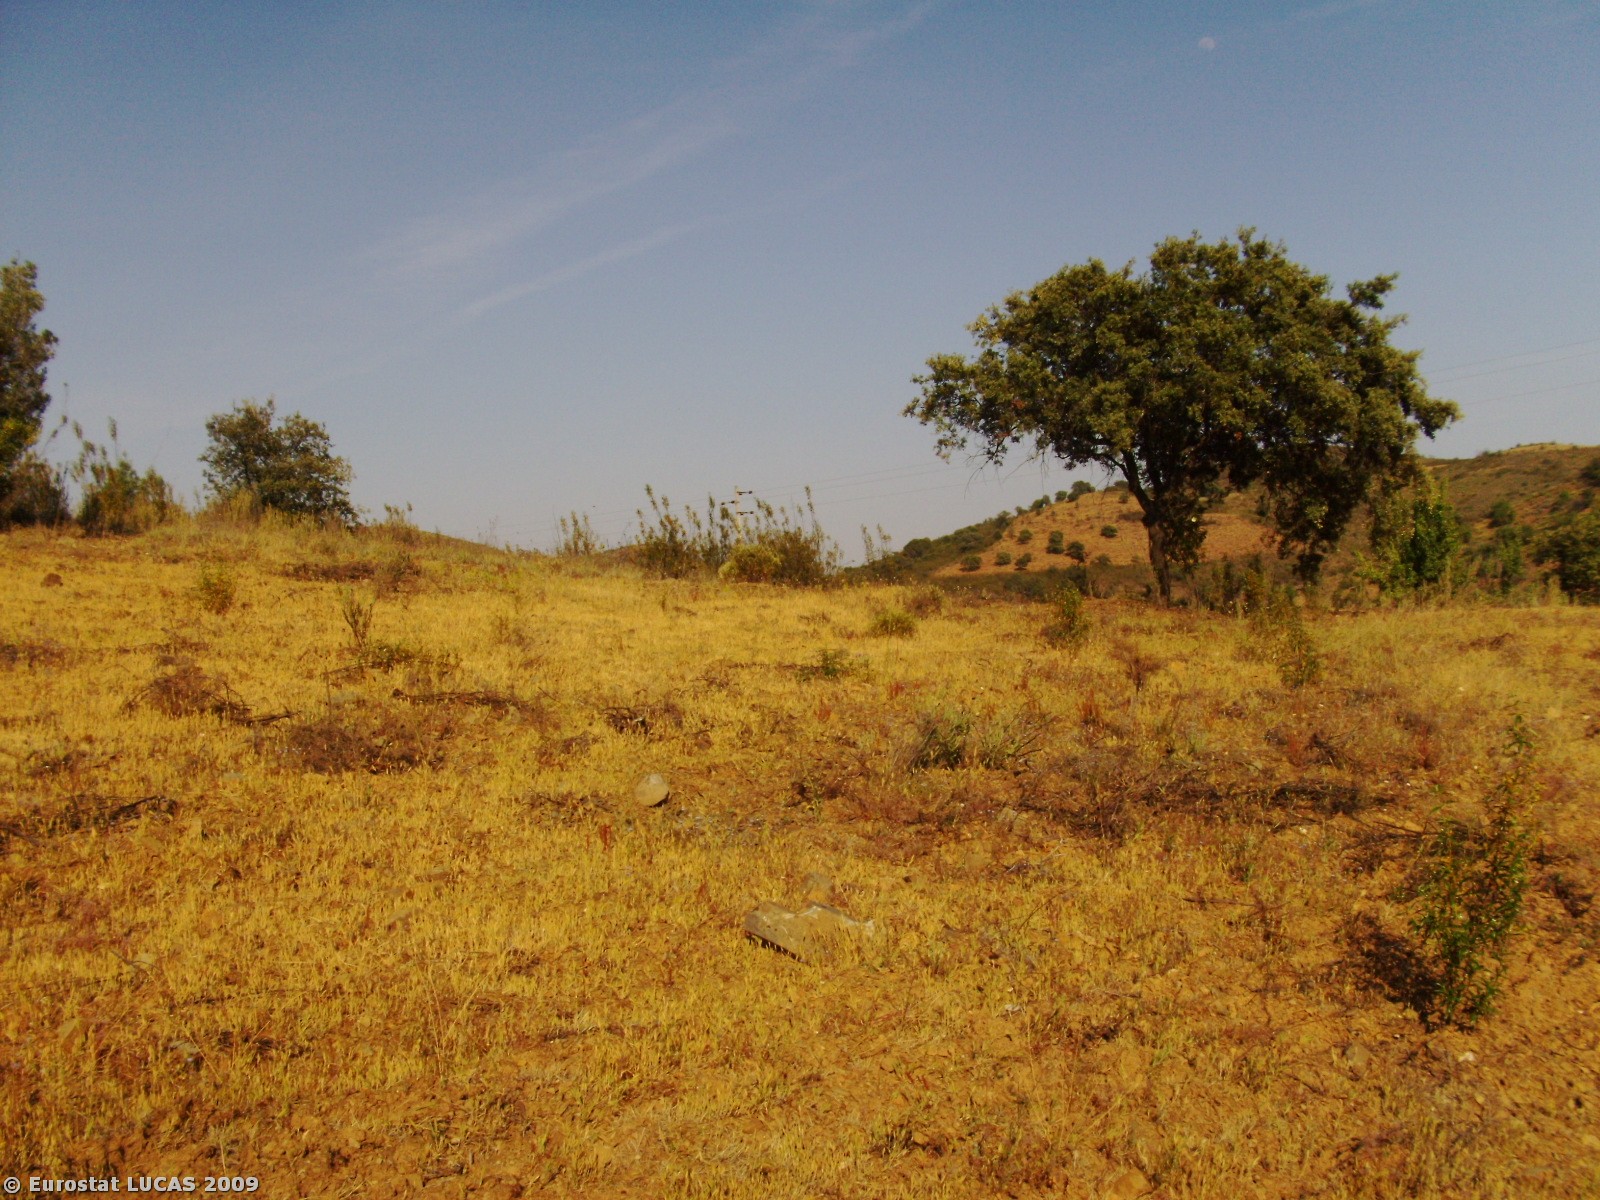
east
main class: Grassland
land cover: Grassland with sparse tree/shrub cover
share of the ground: 25 - 50 %
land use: Forestry
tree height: > 5 m
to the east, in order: Grassland with sparse tree/shrub cover; Shrubland with sparse tree cover; Tracks; Grassland without tree/shrub cover; Rivers and streams; Shrubland with sparse tree cover; Shruby margins; Tracks; Shruby margins; Rivers and streams
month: May
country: PT
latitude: 37.3827
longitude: -7.5242
